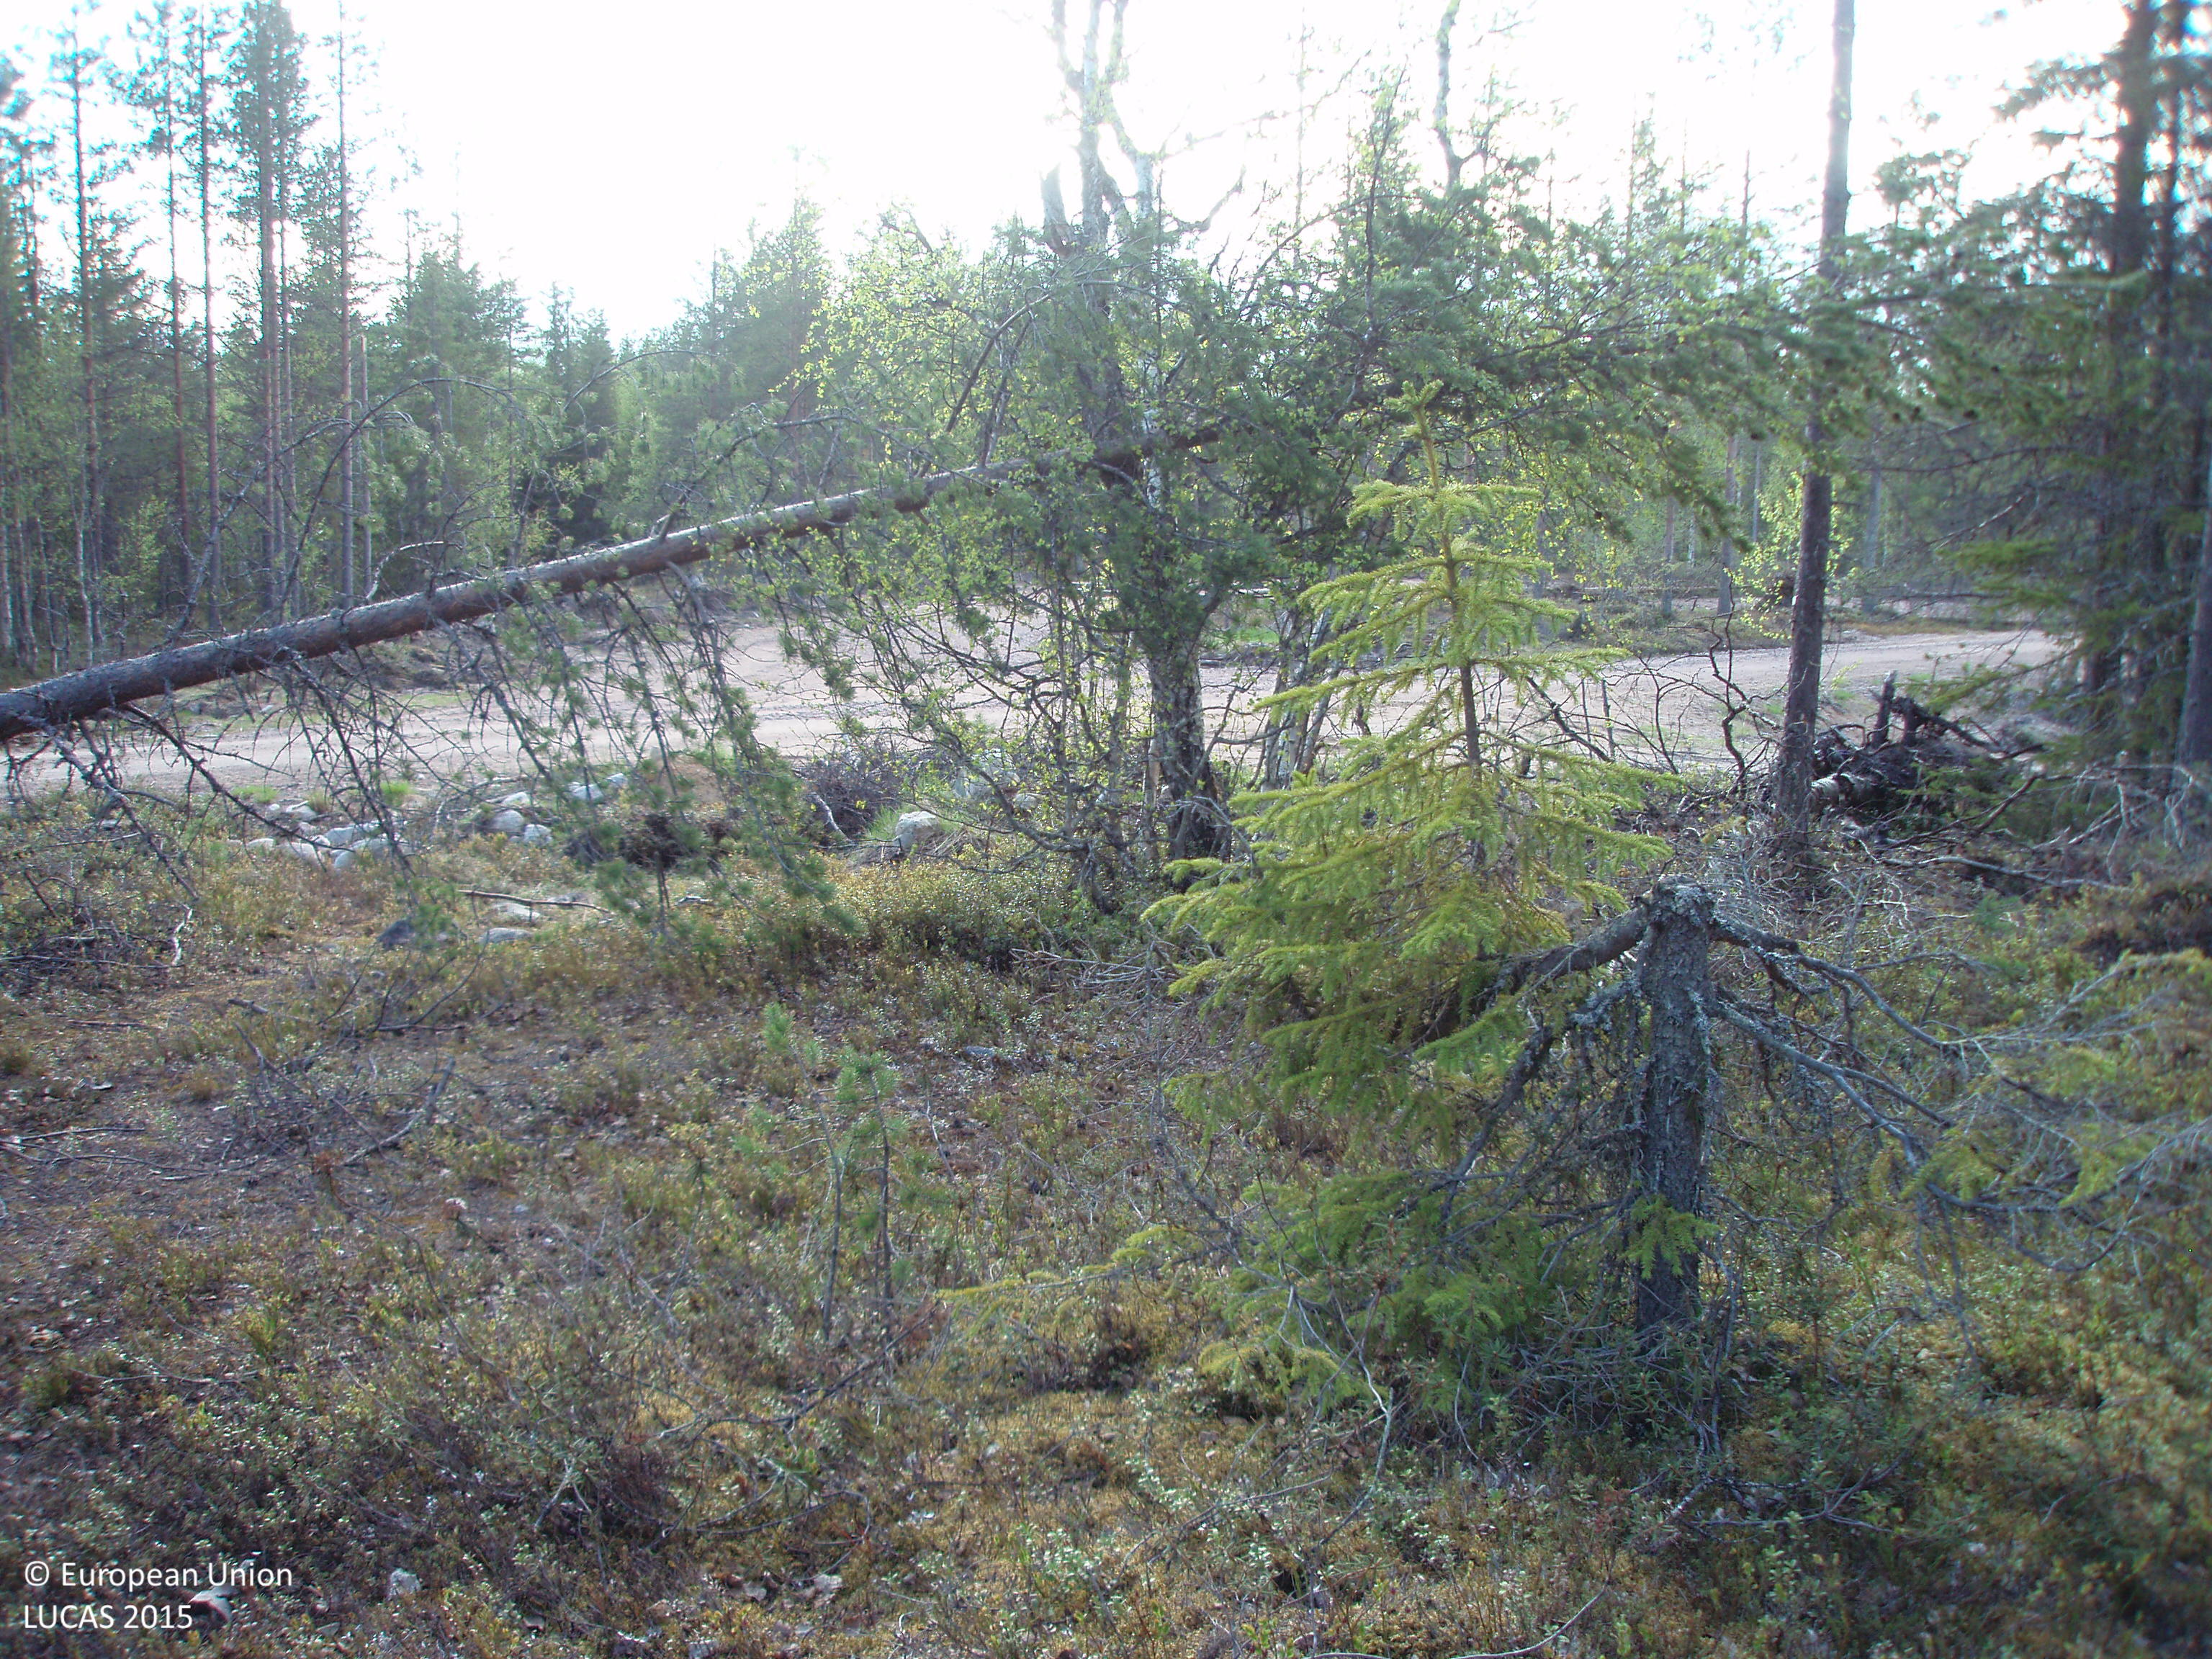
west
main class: Woodland
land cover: Pine dominated coniferous woodland
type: boreal forest
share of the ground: 50 - 75 %
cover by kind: coniferous forest trees 65 %, shrubs 20 %, broadleaved forest trees 5 %, lichens and mosses 5 %, unconsolidated bare surface 5 %
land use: Forestry
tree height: > 5 m
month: June
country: FI
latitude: 66.6787
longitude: 26.5419
